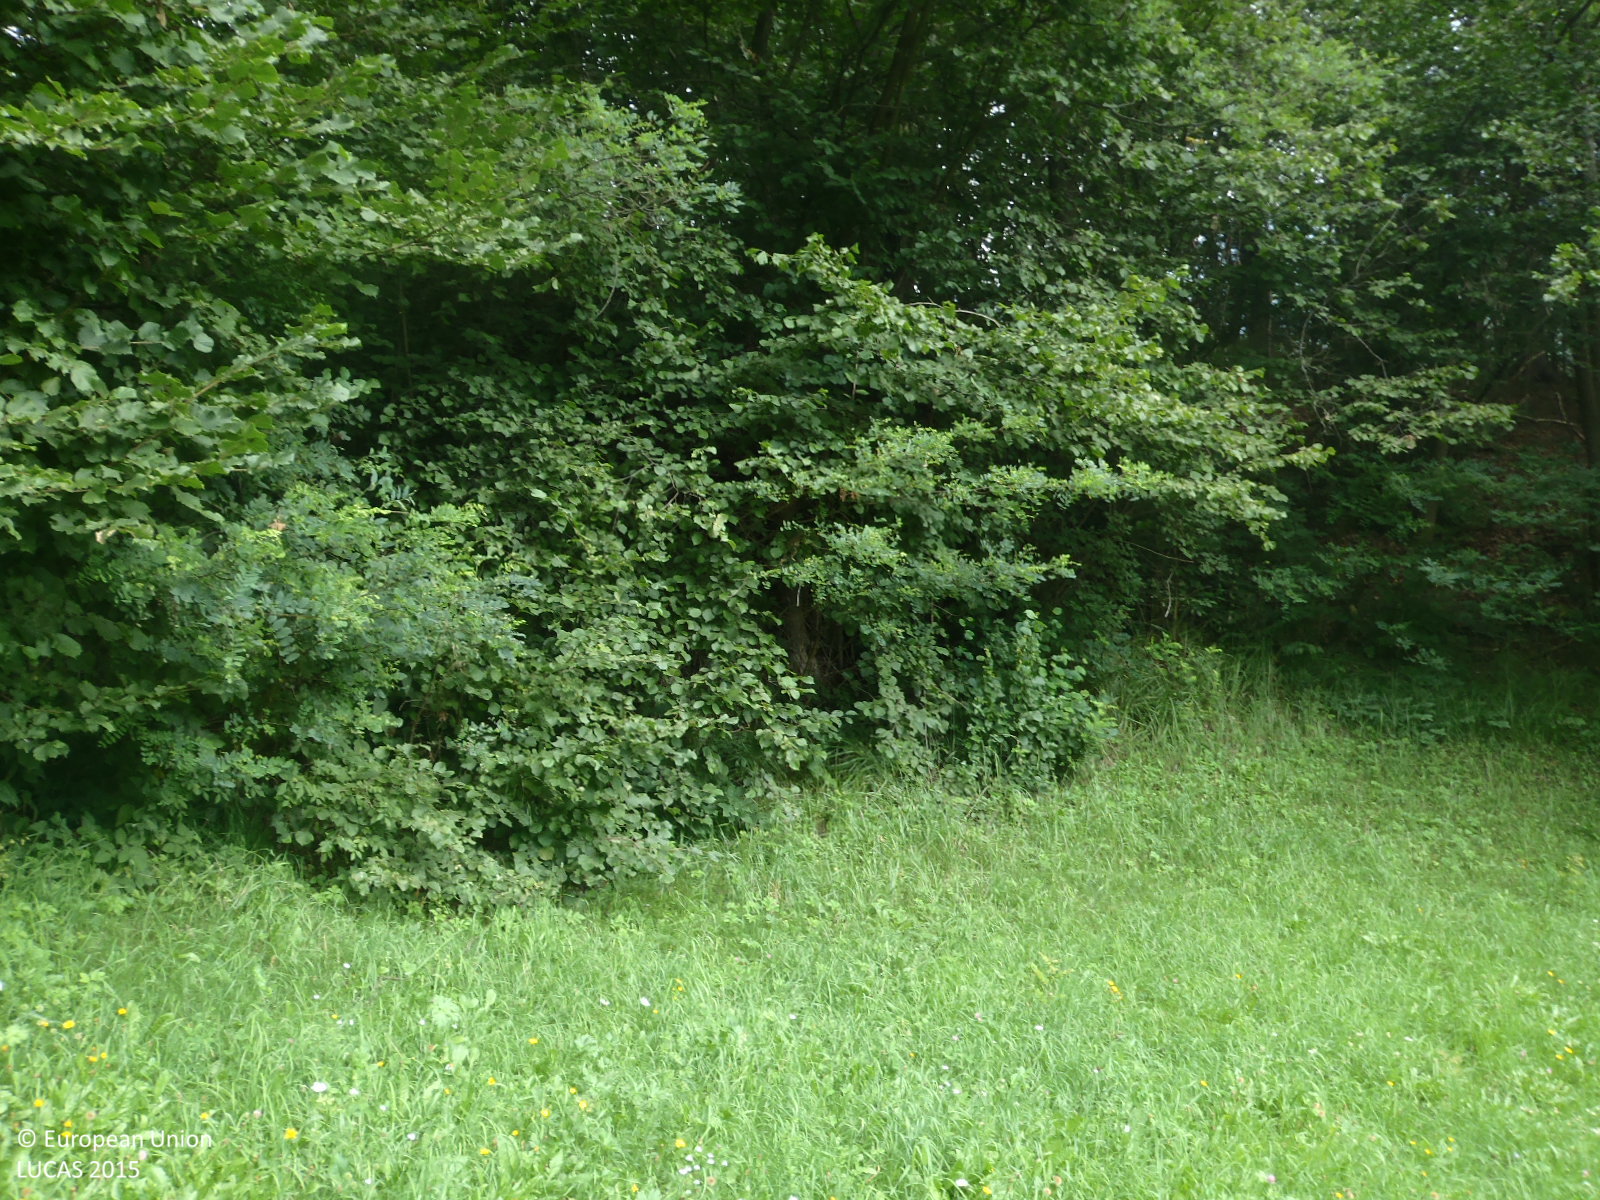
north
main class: Grassland
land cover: Grassland without tree/shrub cover
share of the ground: > 75 %
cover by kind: herbaceous plants 100 %
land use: Agriculture (excluding fallow land and kitchen gardens)
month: August
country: AT
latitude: 46.8767
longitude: 12.6612
